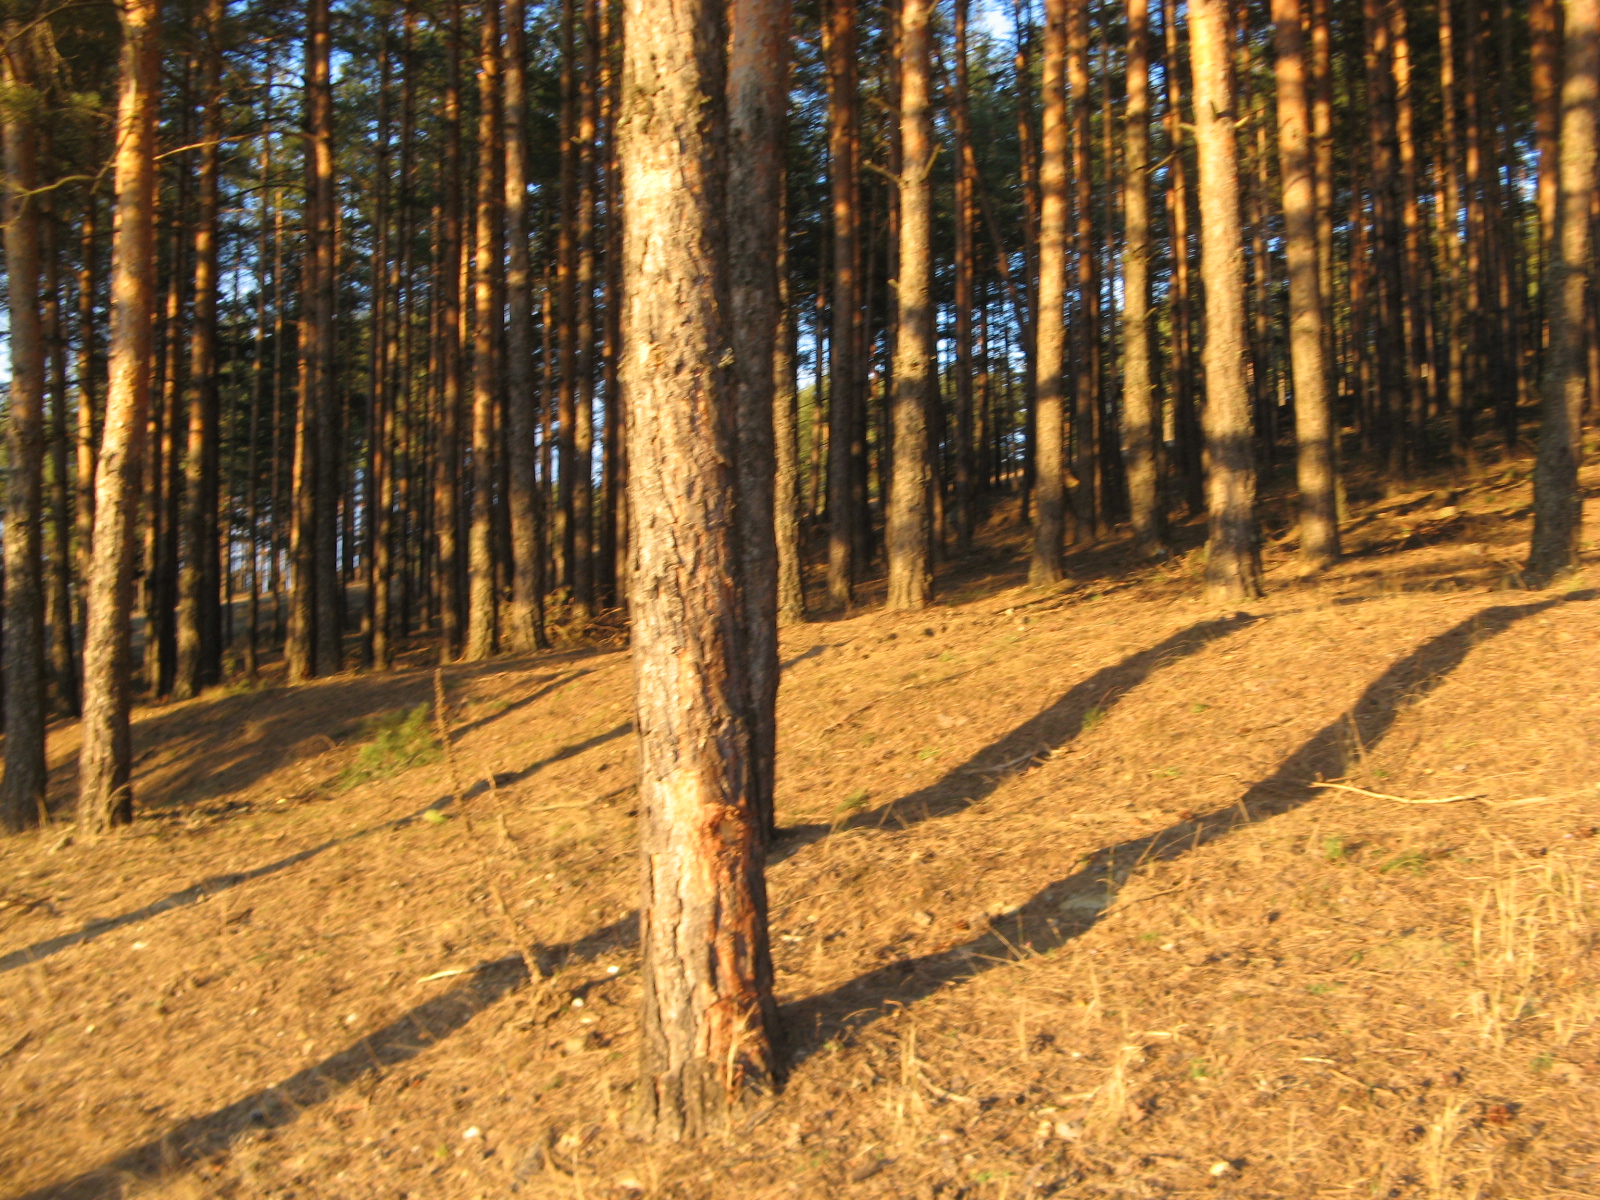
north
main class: Woodland
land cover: Pine dominated coniferous woodland
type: hemiboreal forest and nemoral coniferous forest and mixed broadleaved-coniferous forest
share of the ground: > 75 %
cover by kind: coniferous forest trees 90 %, herbaceous plants 5 %, unconsolidated bare surface 5 %
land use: Forestry
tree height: > 5 m
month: December
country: BG
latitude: 42.0411
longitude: 24.1379
